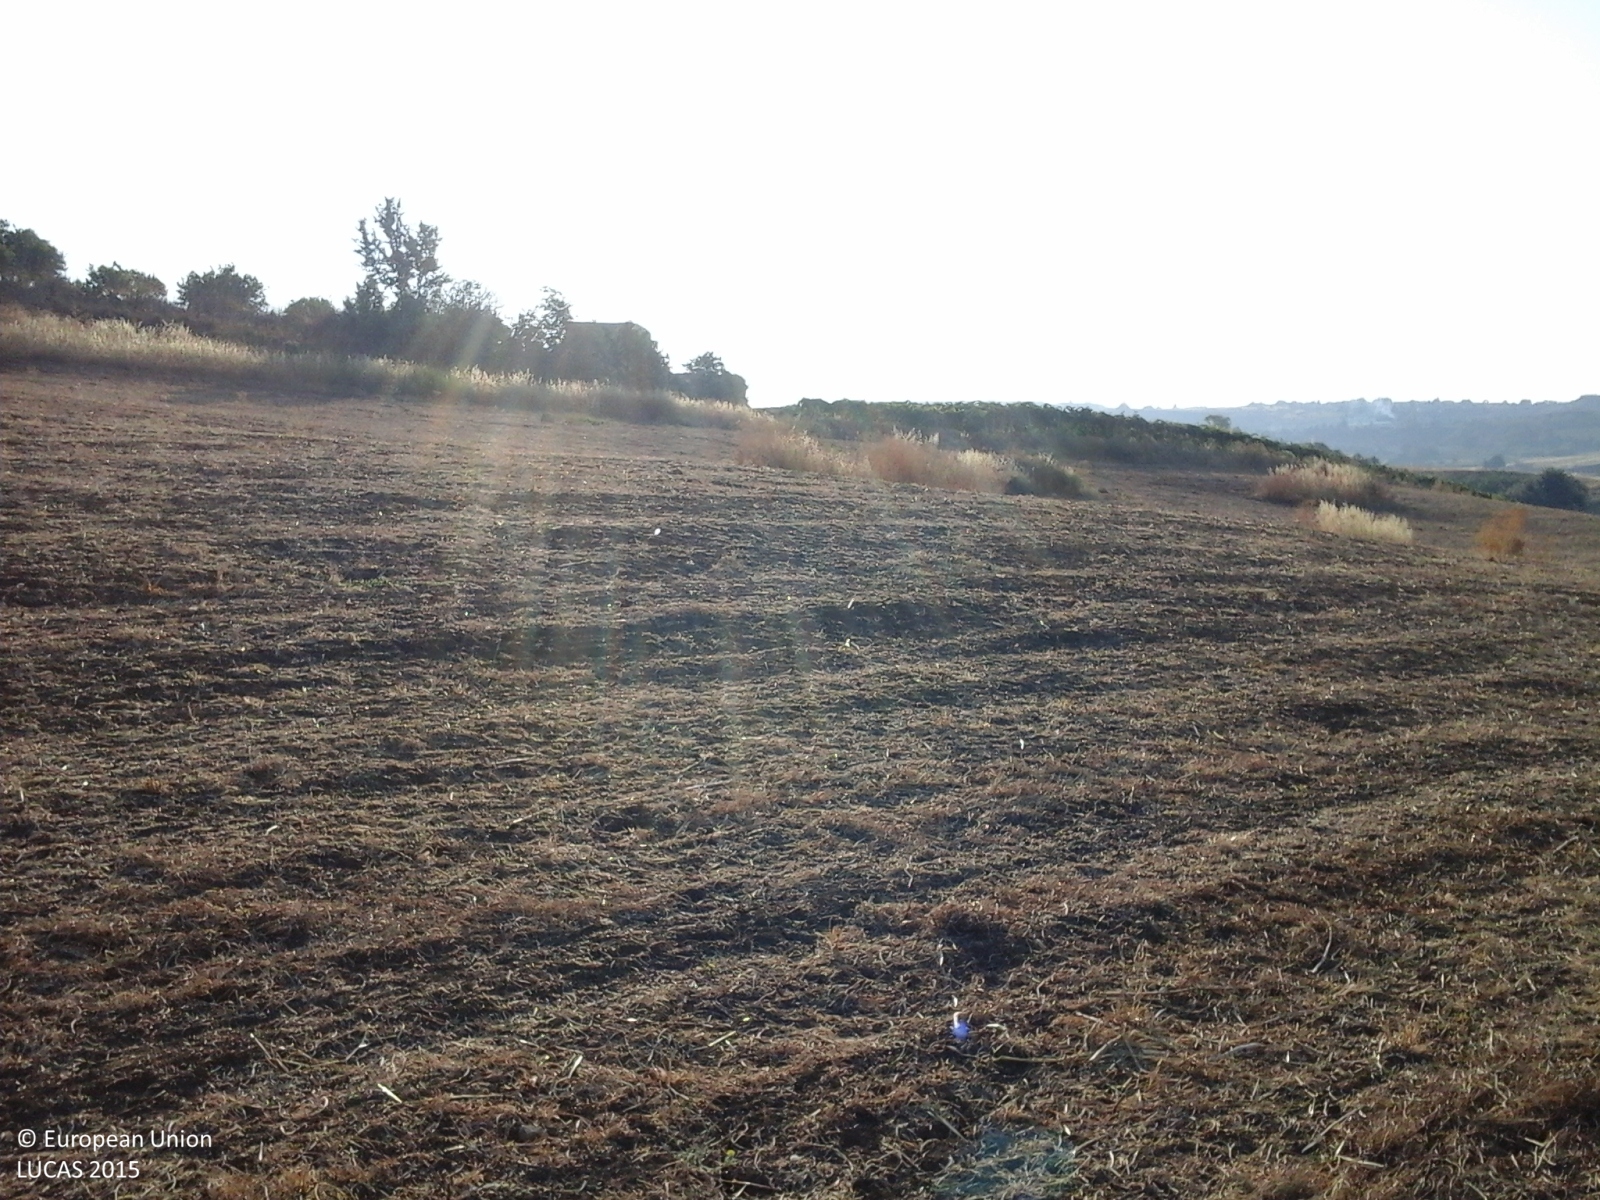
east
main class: Cropland
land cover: Temporary grasslands
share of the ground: > 75 %
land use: Agriculture (excluding fallow land and kitchen gardens)
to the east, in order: Temporary grasslands; Grass margins; Vineyards; Rivers and streams; Spontaneously vegetated surfaces
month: July
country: IT
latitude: 37.2729
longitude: 13.7711
